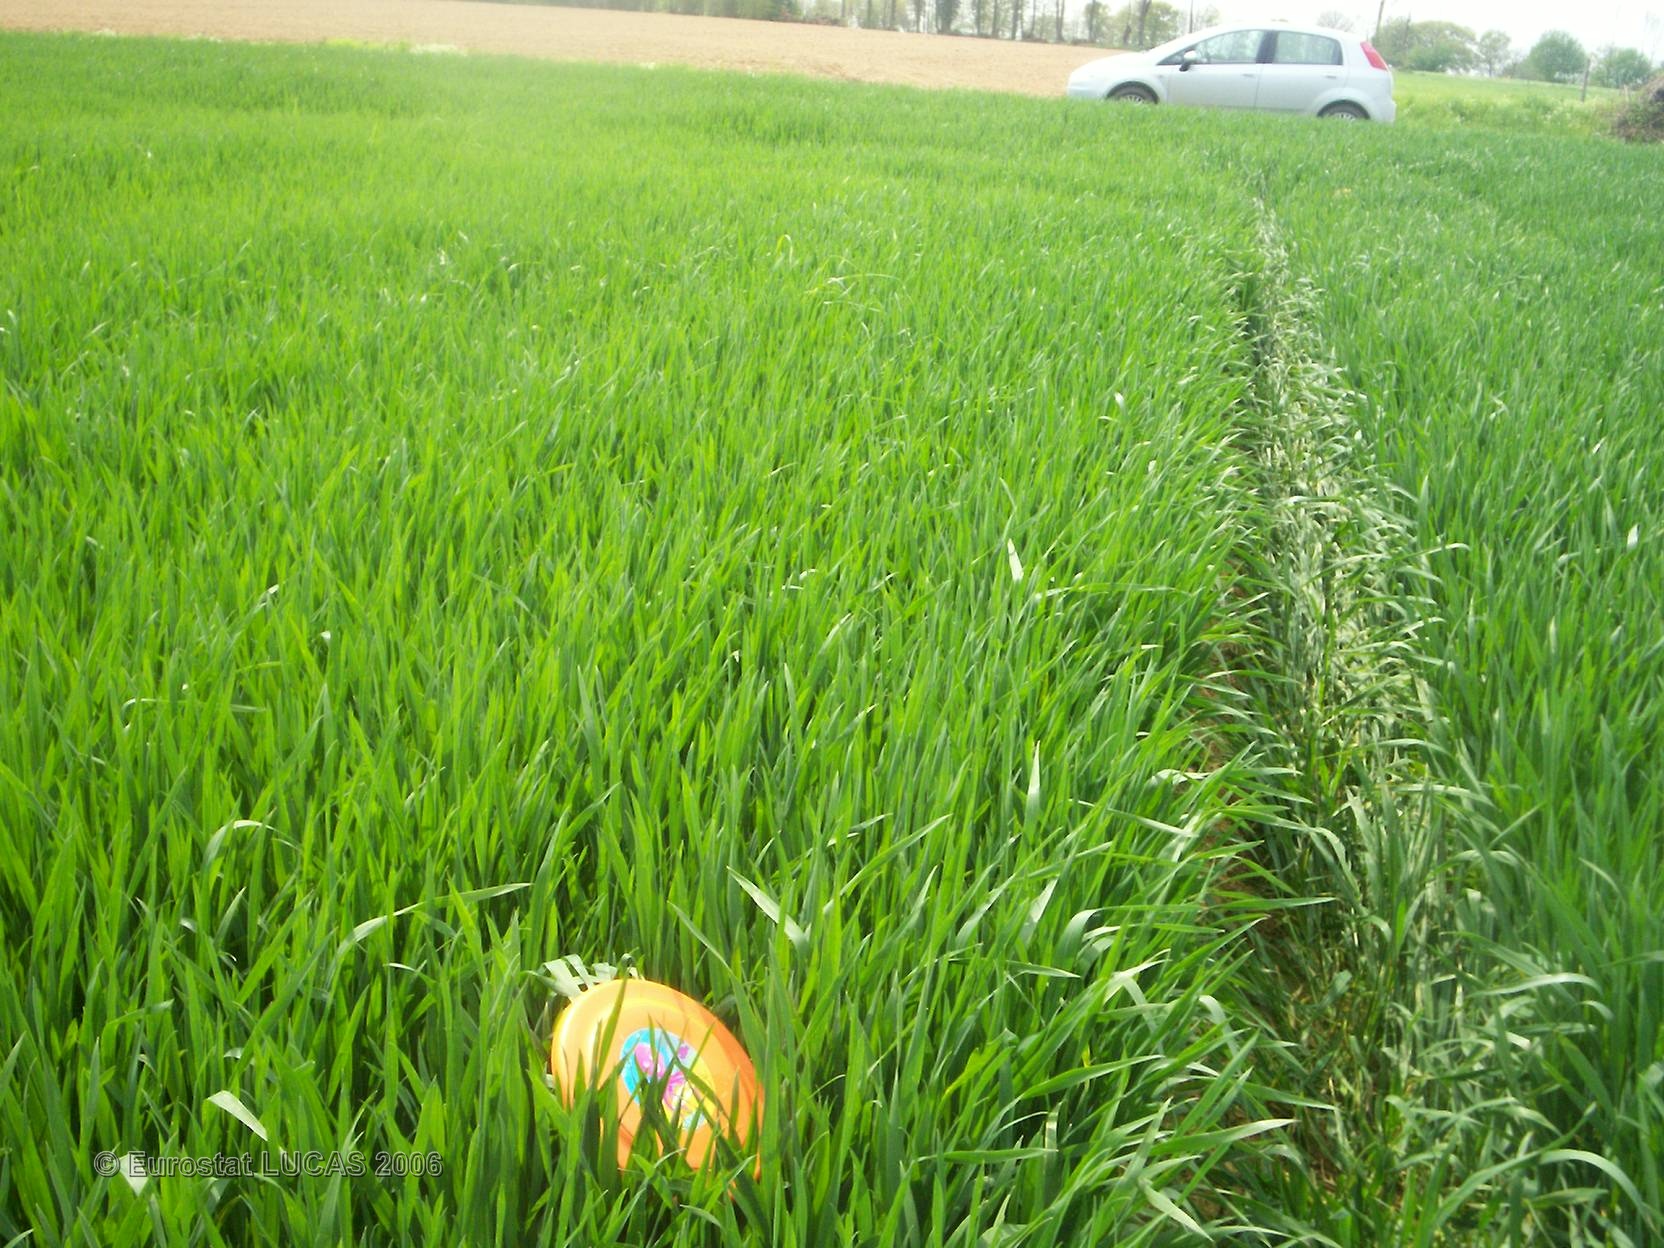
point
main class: Cropland
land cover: Common wheat
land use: Agriculture (excluding fallow land and kitchen gardens)
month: May
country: FR
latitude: 47.9135
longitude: -1.2949
